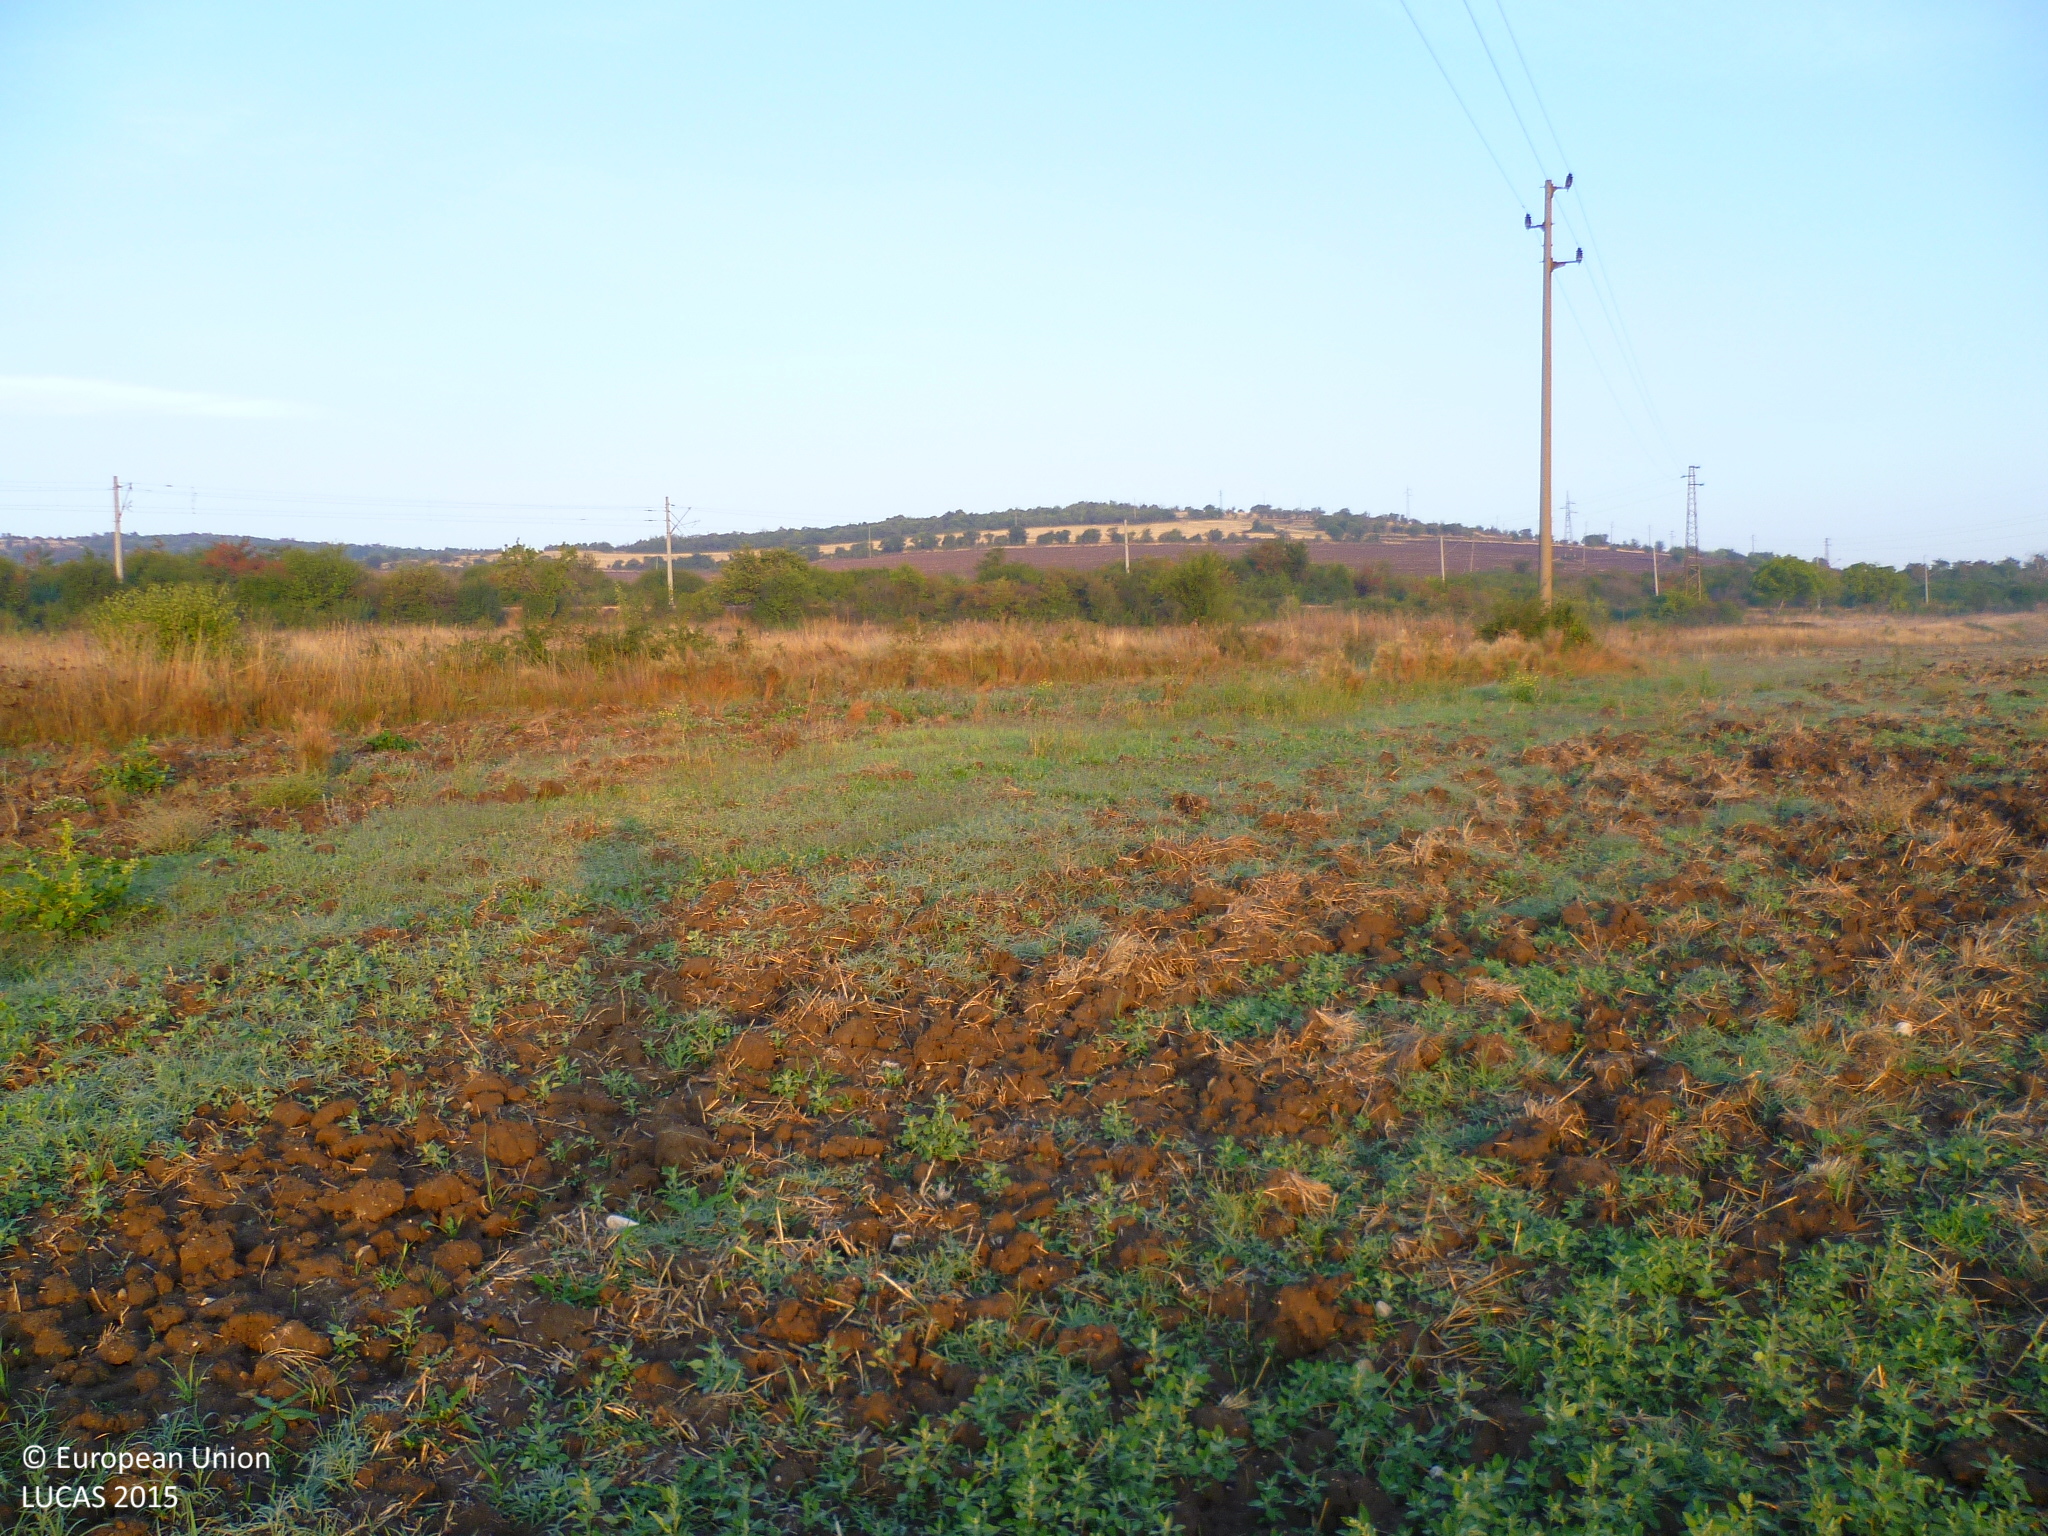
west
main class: Cropland
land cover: Rye
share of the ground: < 10 %
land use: Agriculture (excluding fallow land and kitchen gardens)
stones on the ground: < 10 %
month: September
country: BG
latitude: 42.8692
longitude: 23.0191
